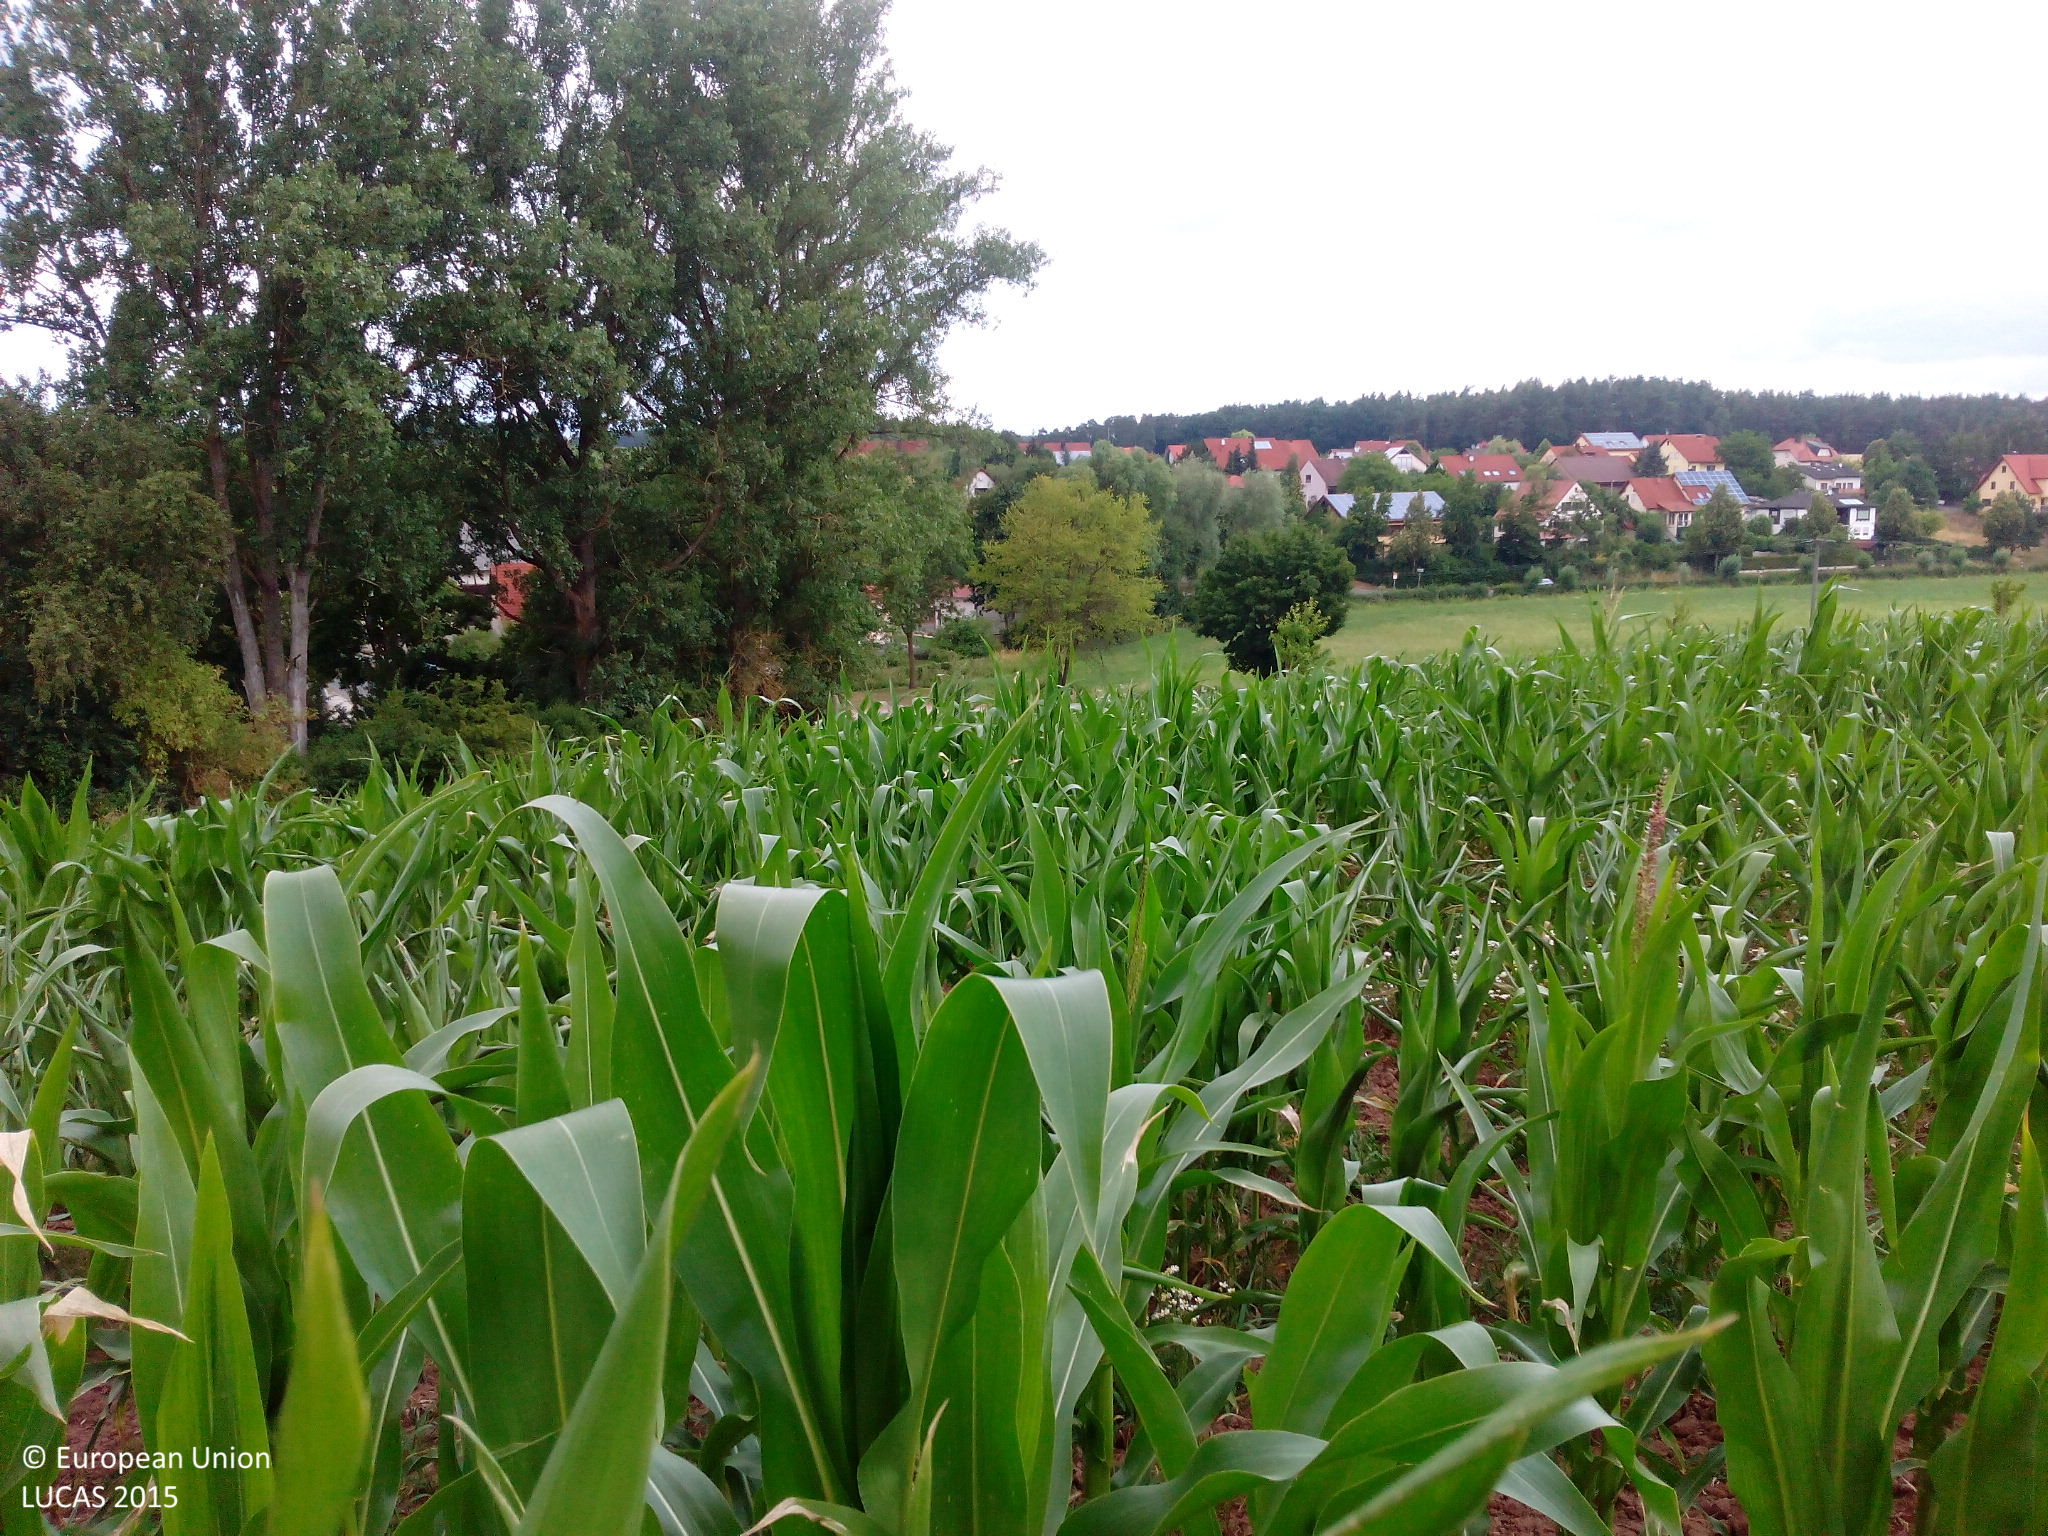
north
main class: Cropland
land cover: Maize
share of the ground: > 75 %
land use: Agriculture (excluding fallow land and kitchen gardens)
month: July
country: DE
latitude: 49.6970
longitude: 10.6236
